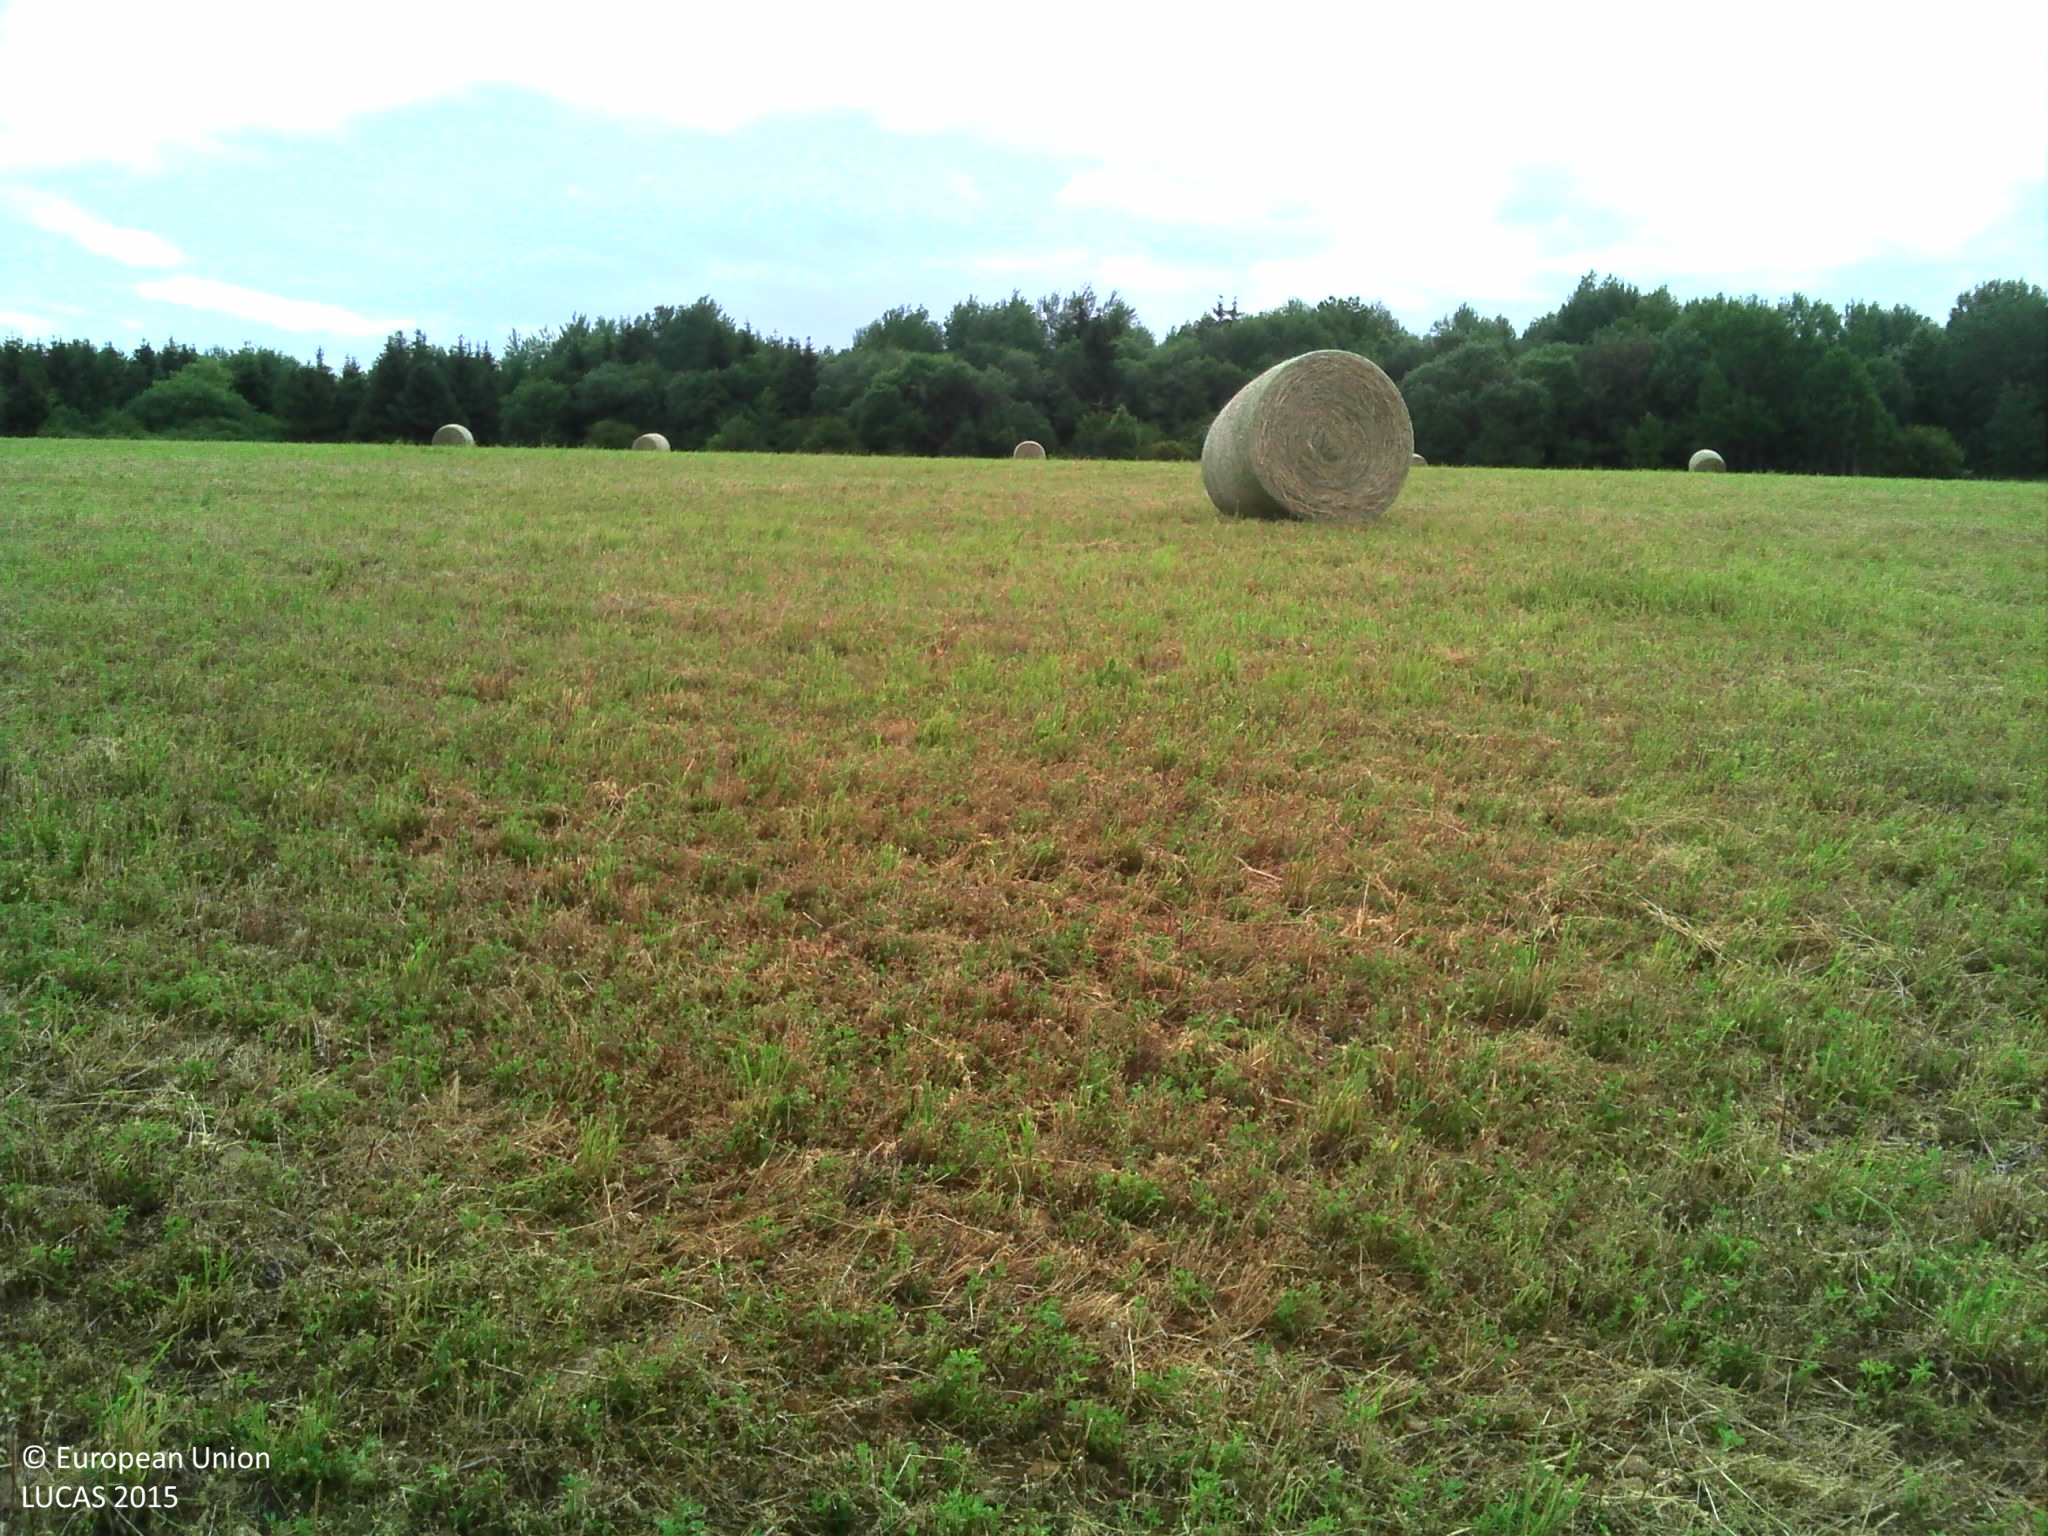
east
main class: Cropland
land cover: Temporary grasslands
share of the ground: > 75 %
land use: Agriculture (excluding fallow land and kitchen gardens)
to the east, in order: Temporary grasslands; Shrubland with sparse tree cover; Spruce dominated mixed woodland
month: June
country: FR
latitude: 48.8075
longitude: 6.2282
